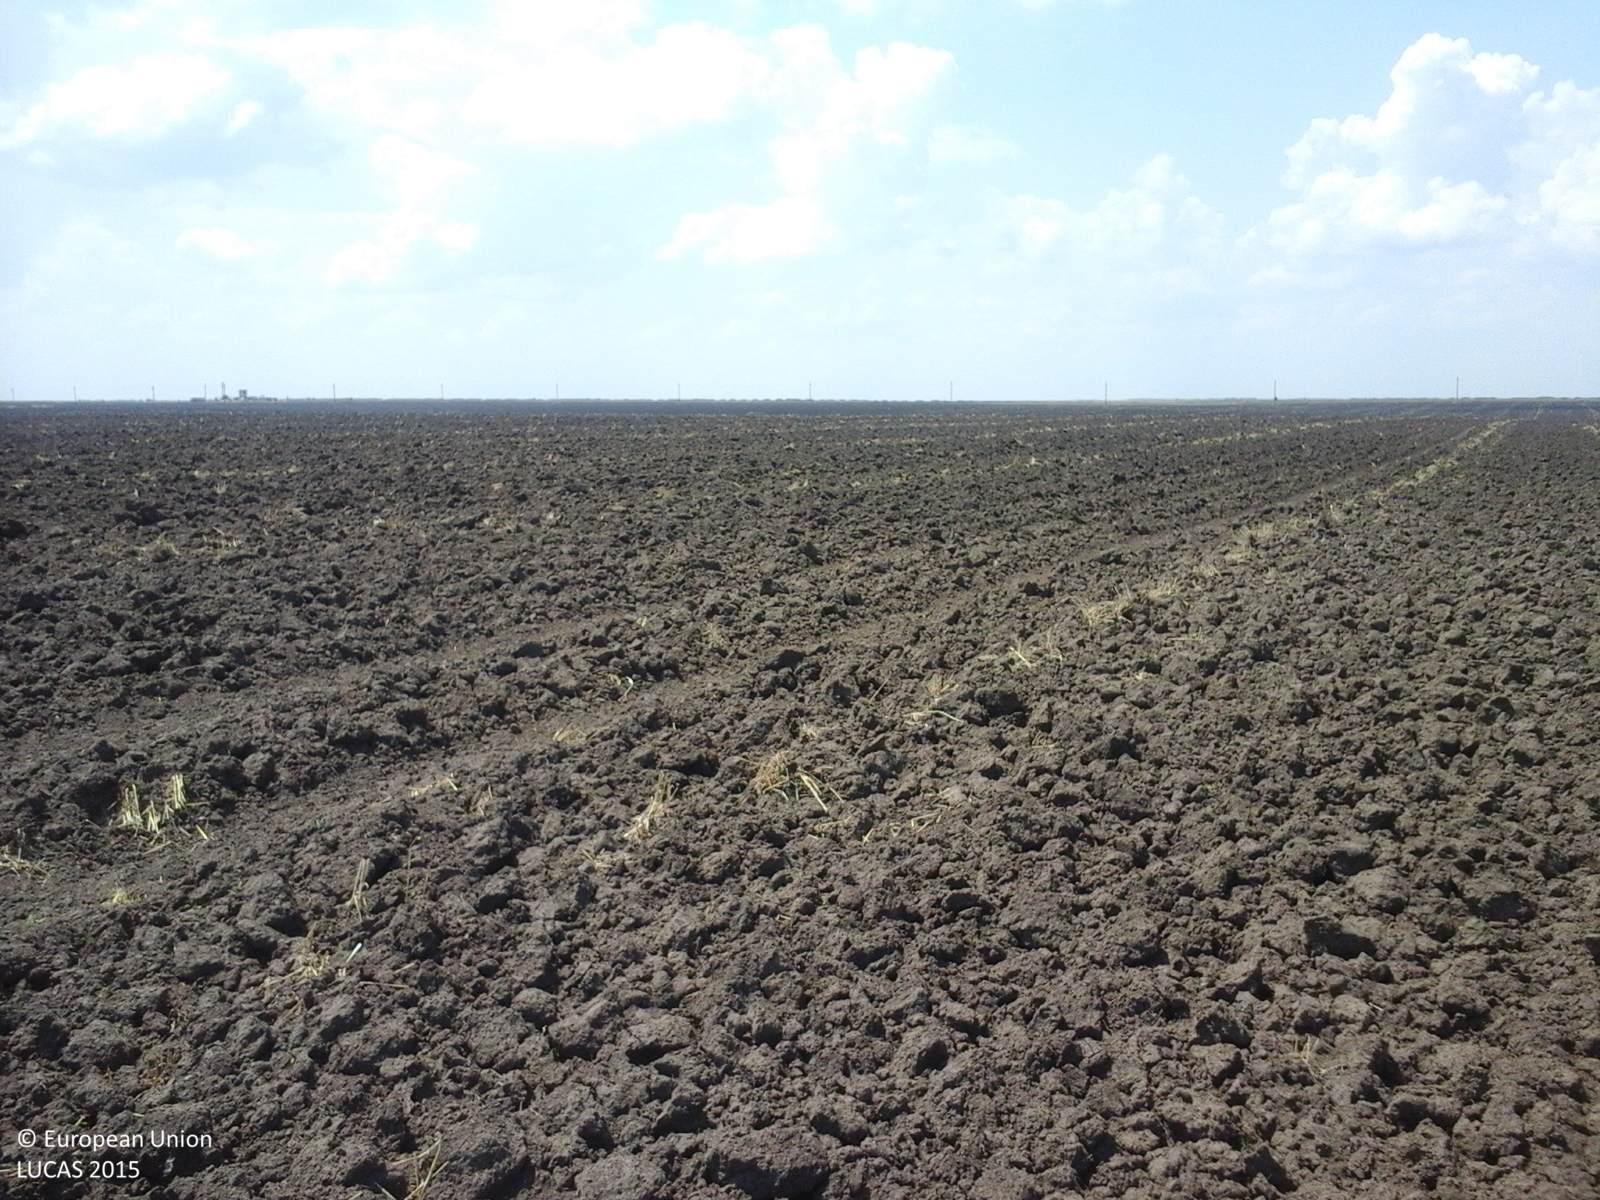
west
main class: Cropland
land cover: Common wheat
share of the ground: < 10 %
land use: Agriculture (excluding fallow land and kitchen gardens)
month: July
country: RO
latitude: 44.0900
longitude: 25.7684
